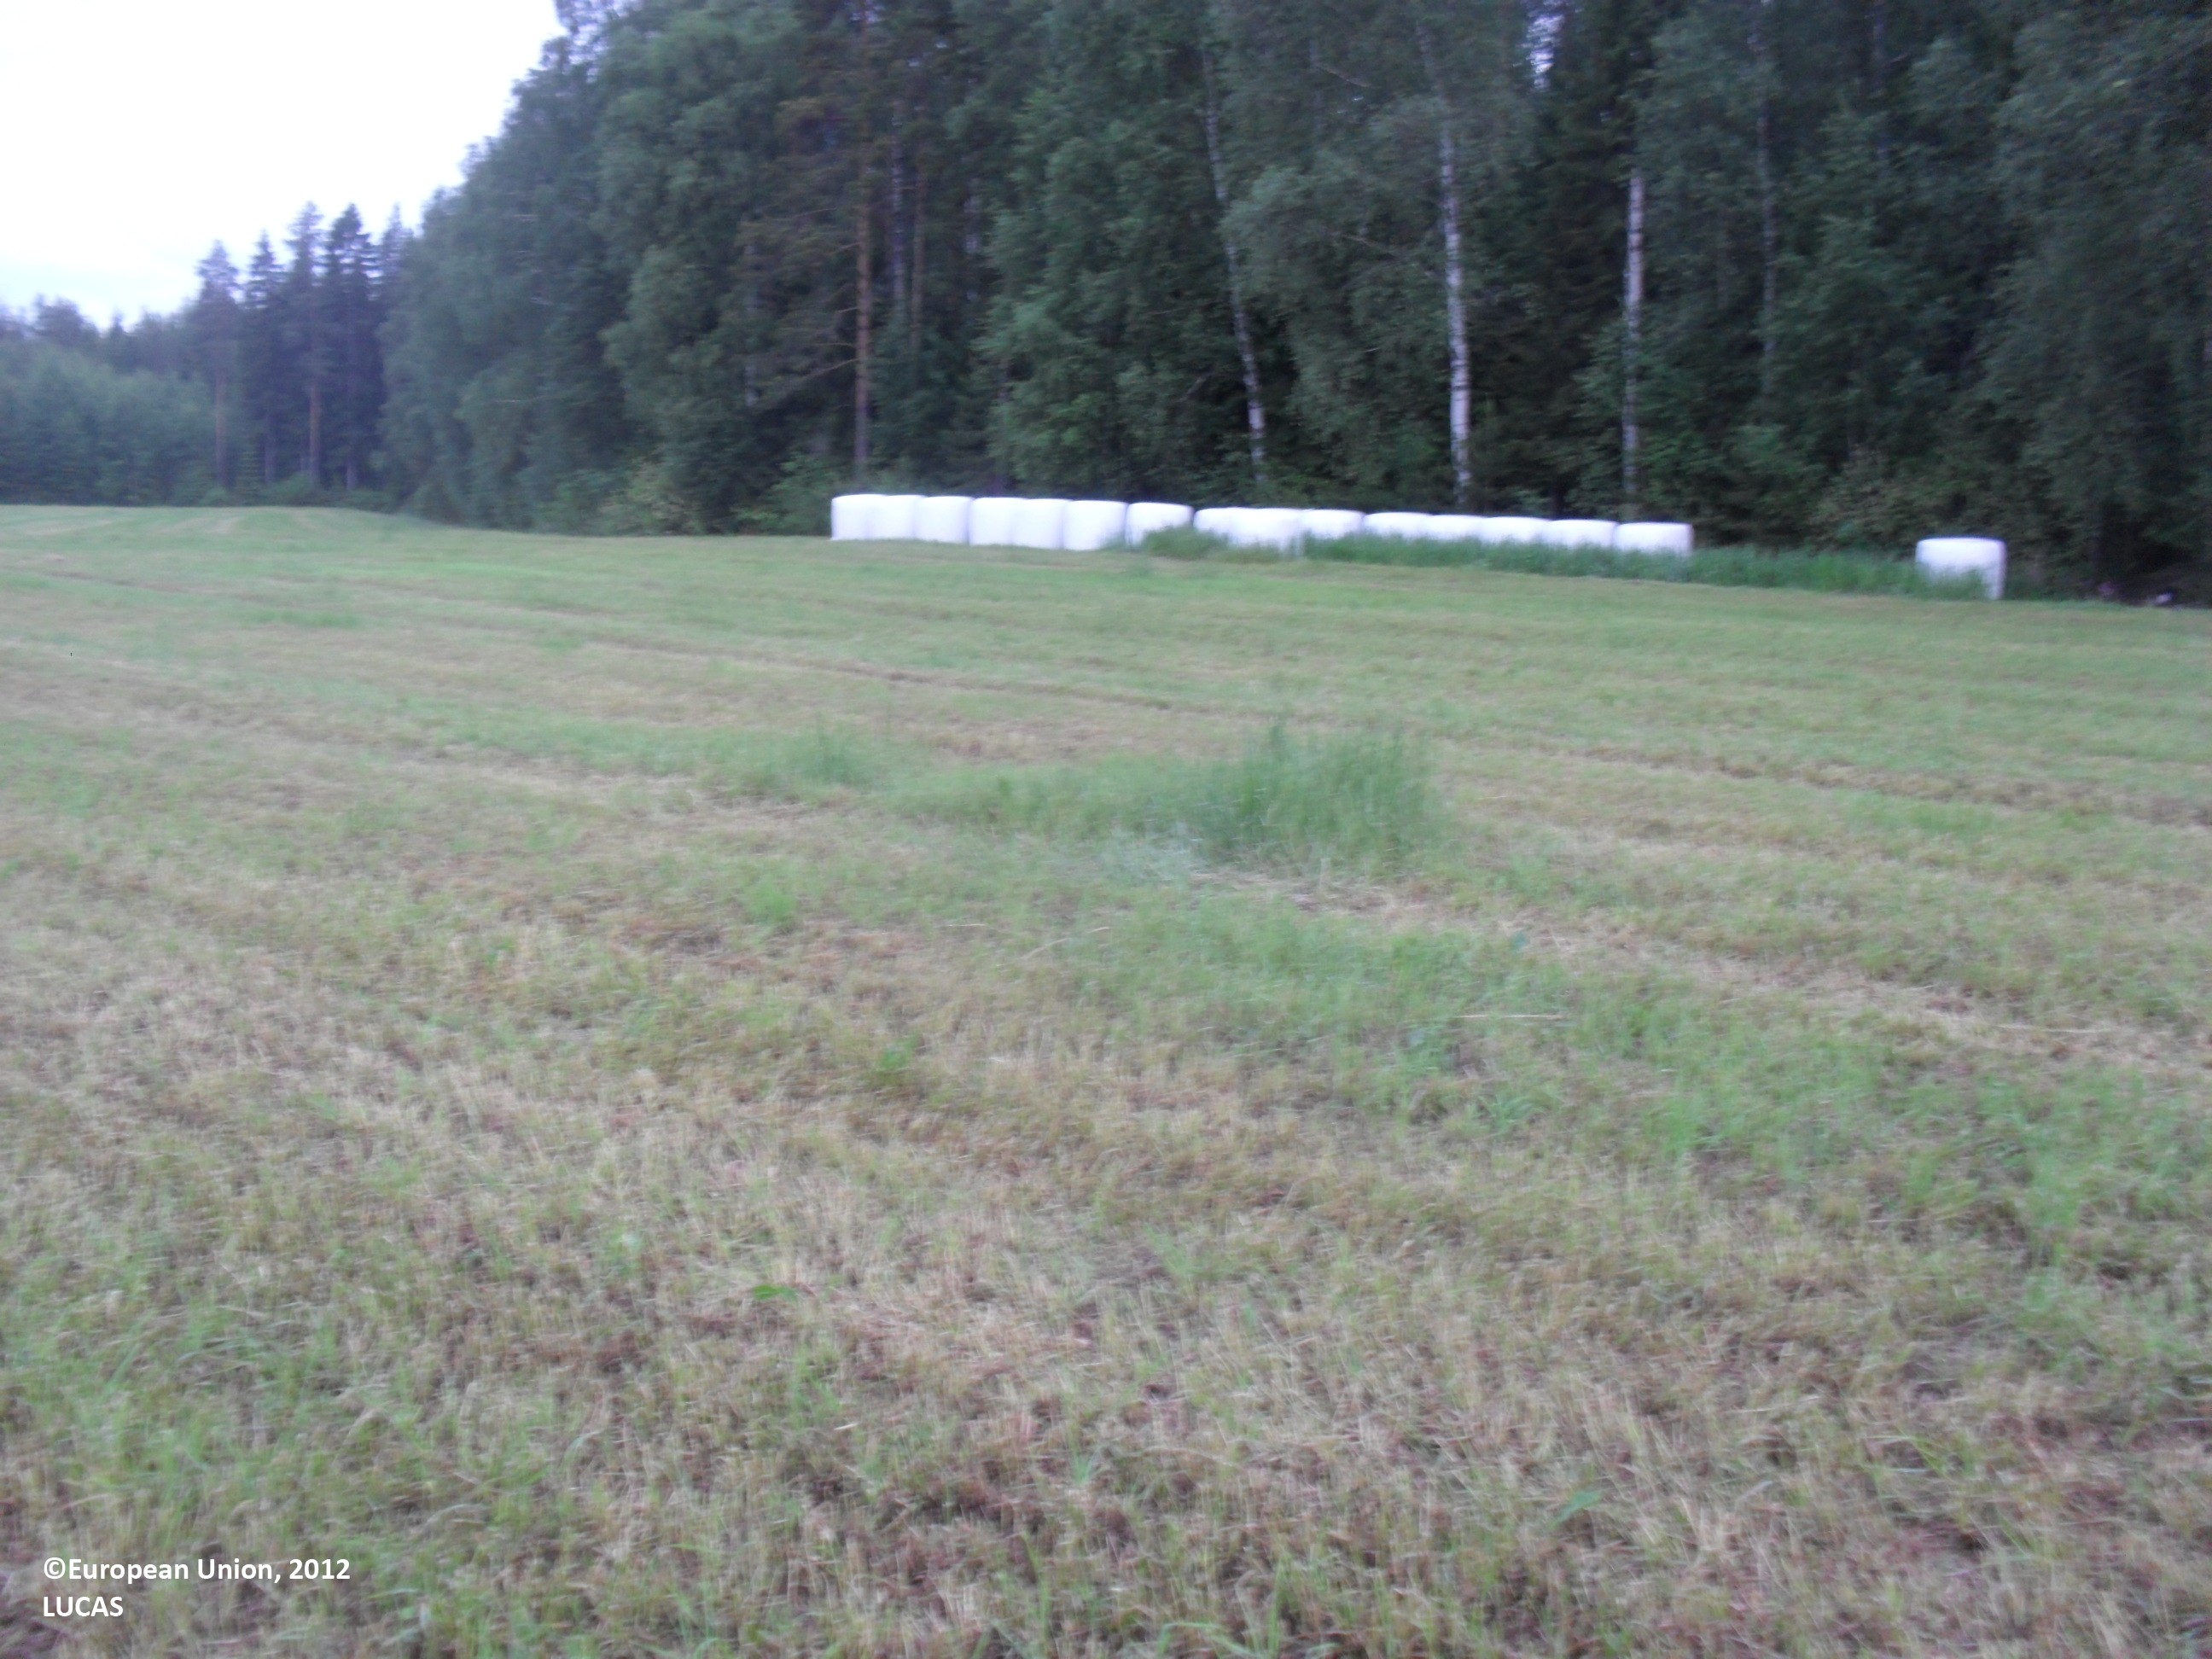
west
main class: Cropland
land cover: Temporary grasslands
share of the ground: > 75 %
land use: Agriculture (excluding fallow land and kitchen gardens)
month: June
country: FI
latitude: 63.3460
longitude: 23.2261
